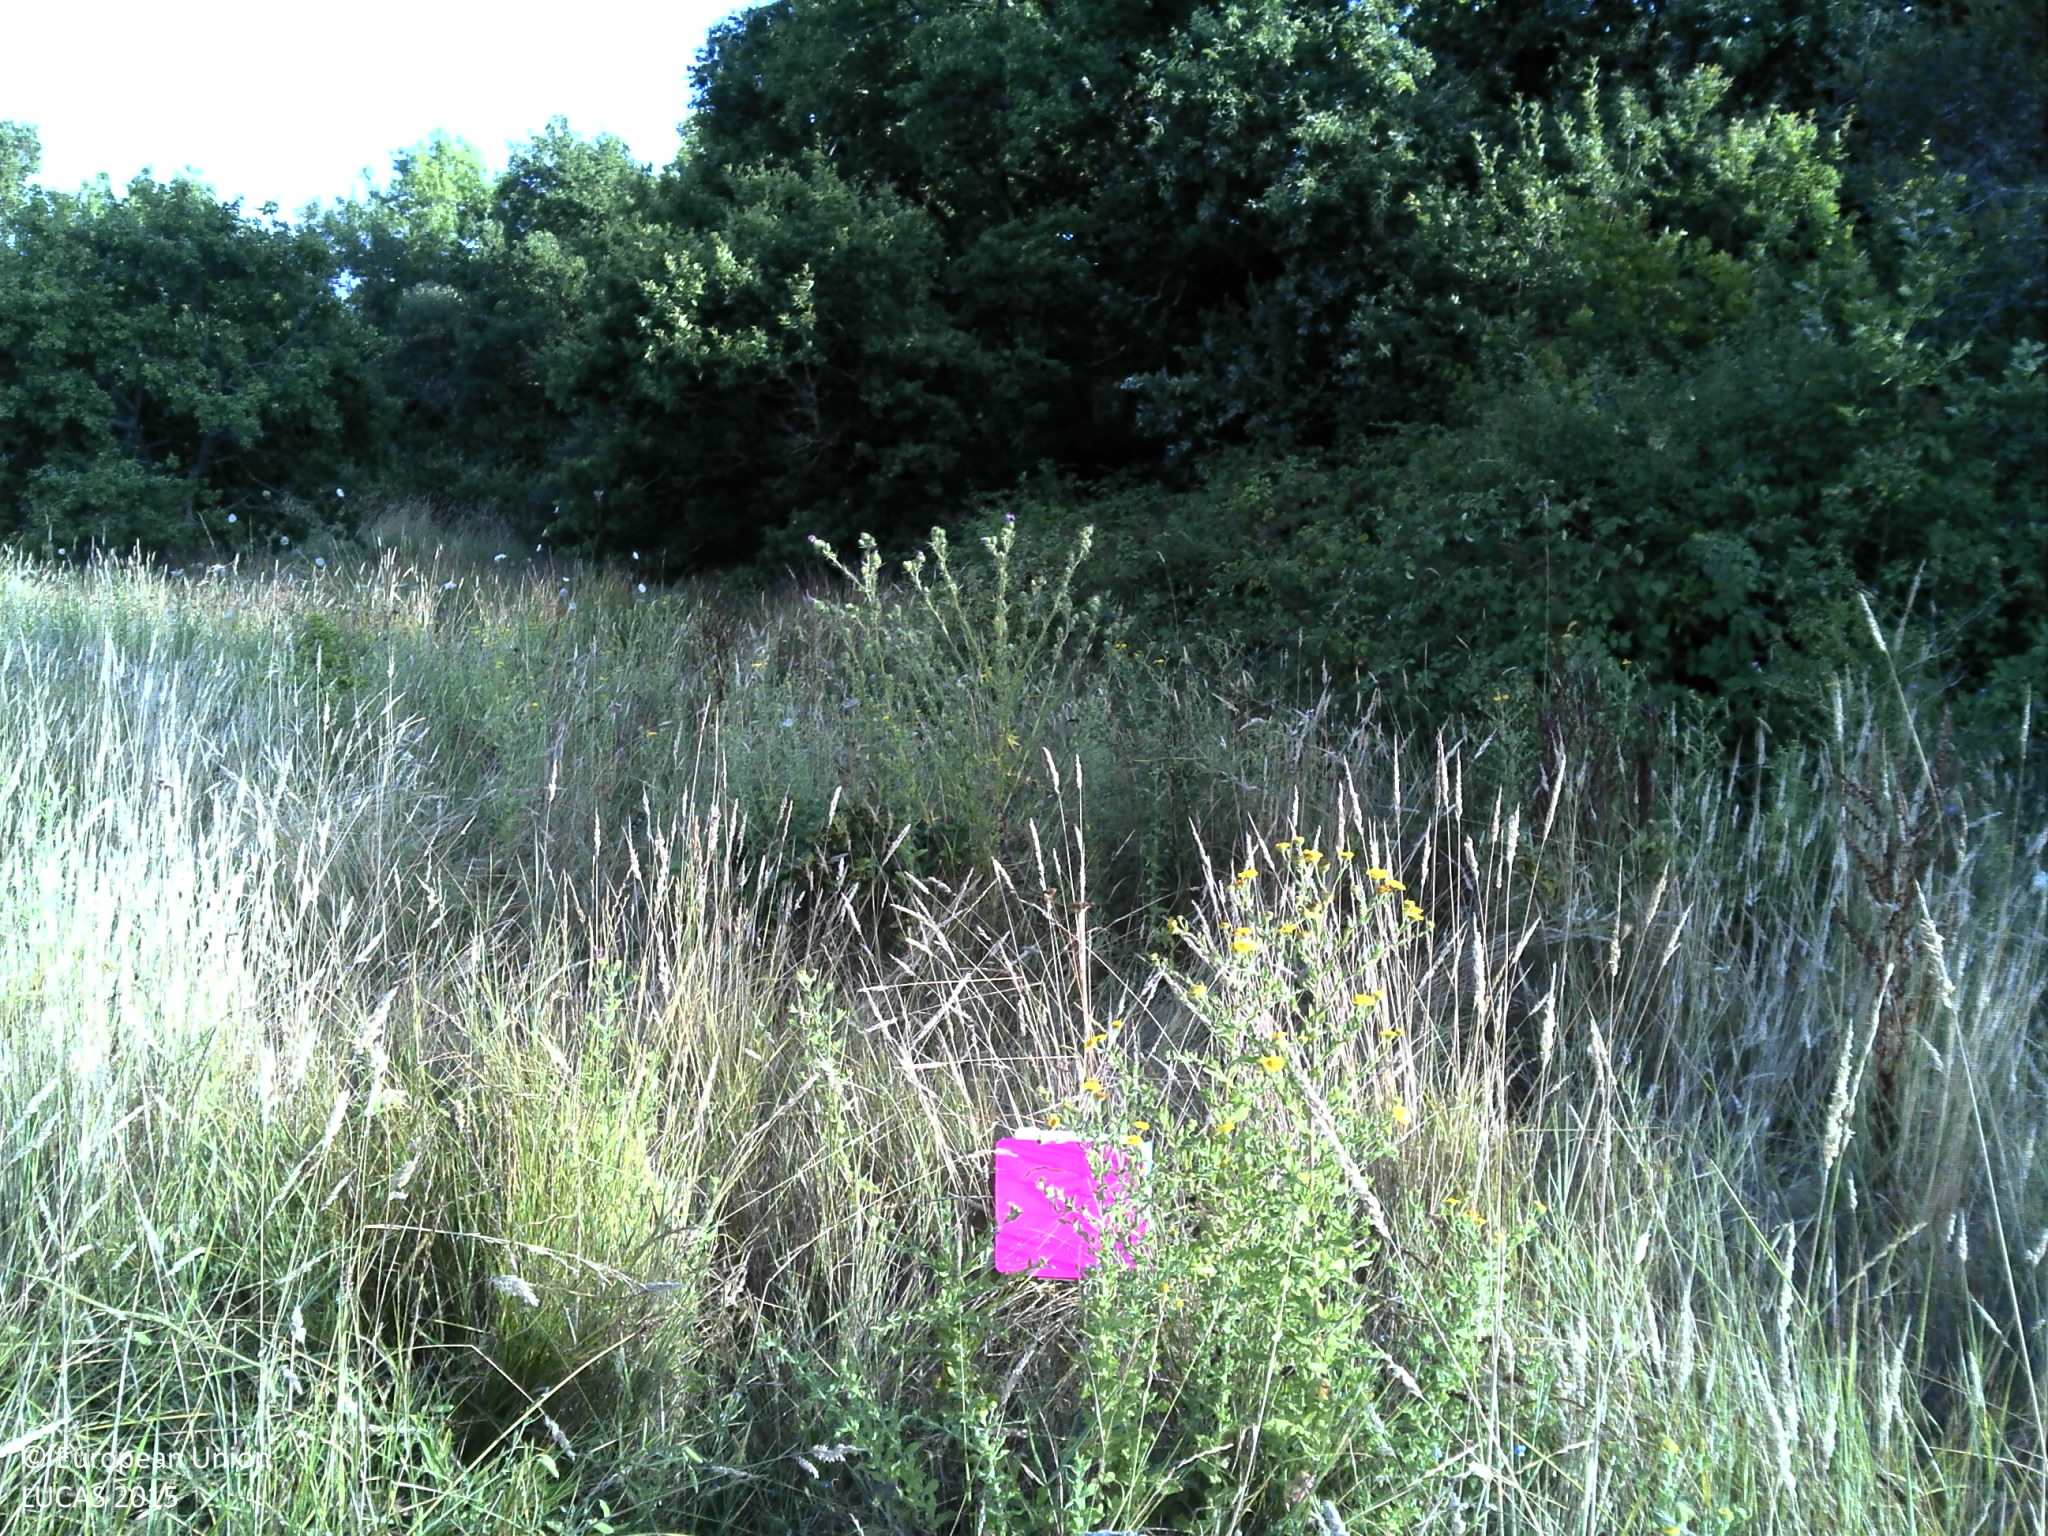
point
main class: Shrubland
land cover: Shrubland without tree cover
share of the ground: > 75 %
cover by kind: herbaceous plants 90 %, shrubs 10 %
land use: Semi-natural and natural areas not in use
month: July
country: FR
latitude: 45.4485
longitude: -1.0613
